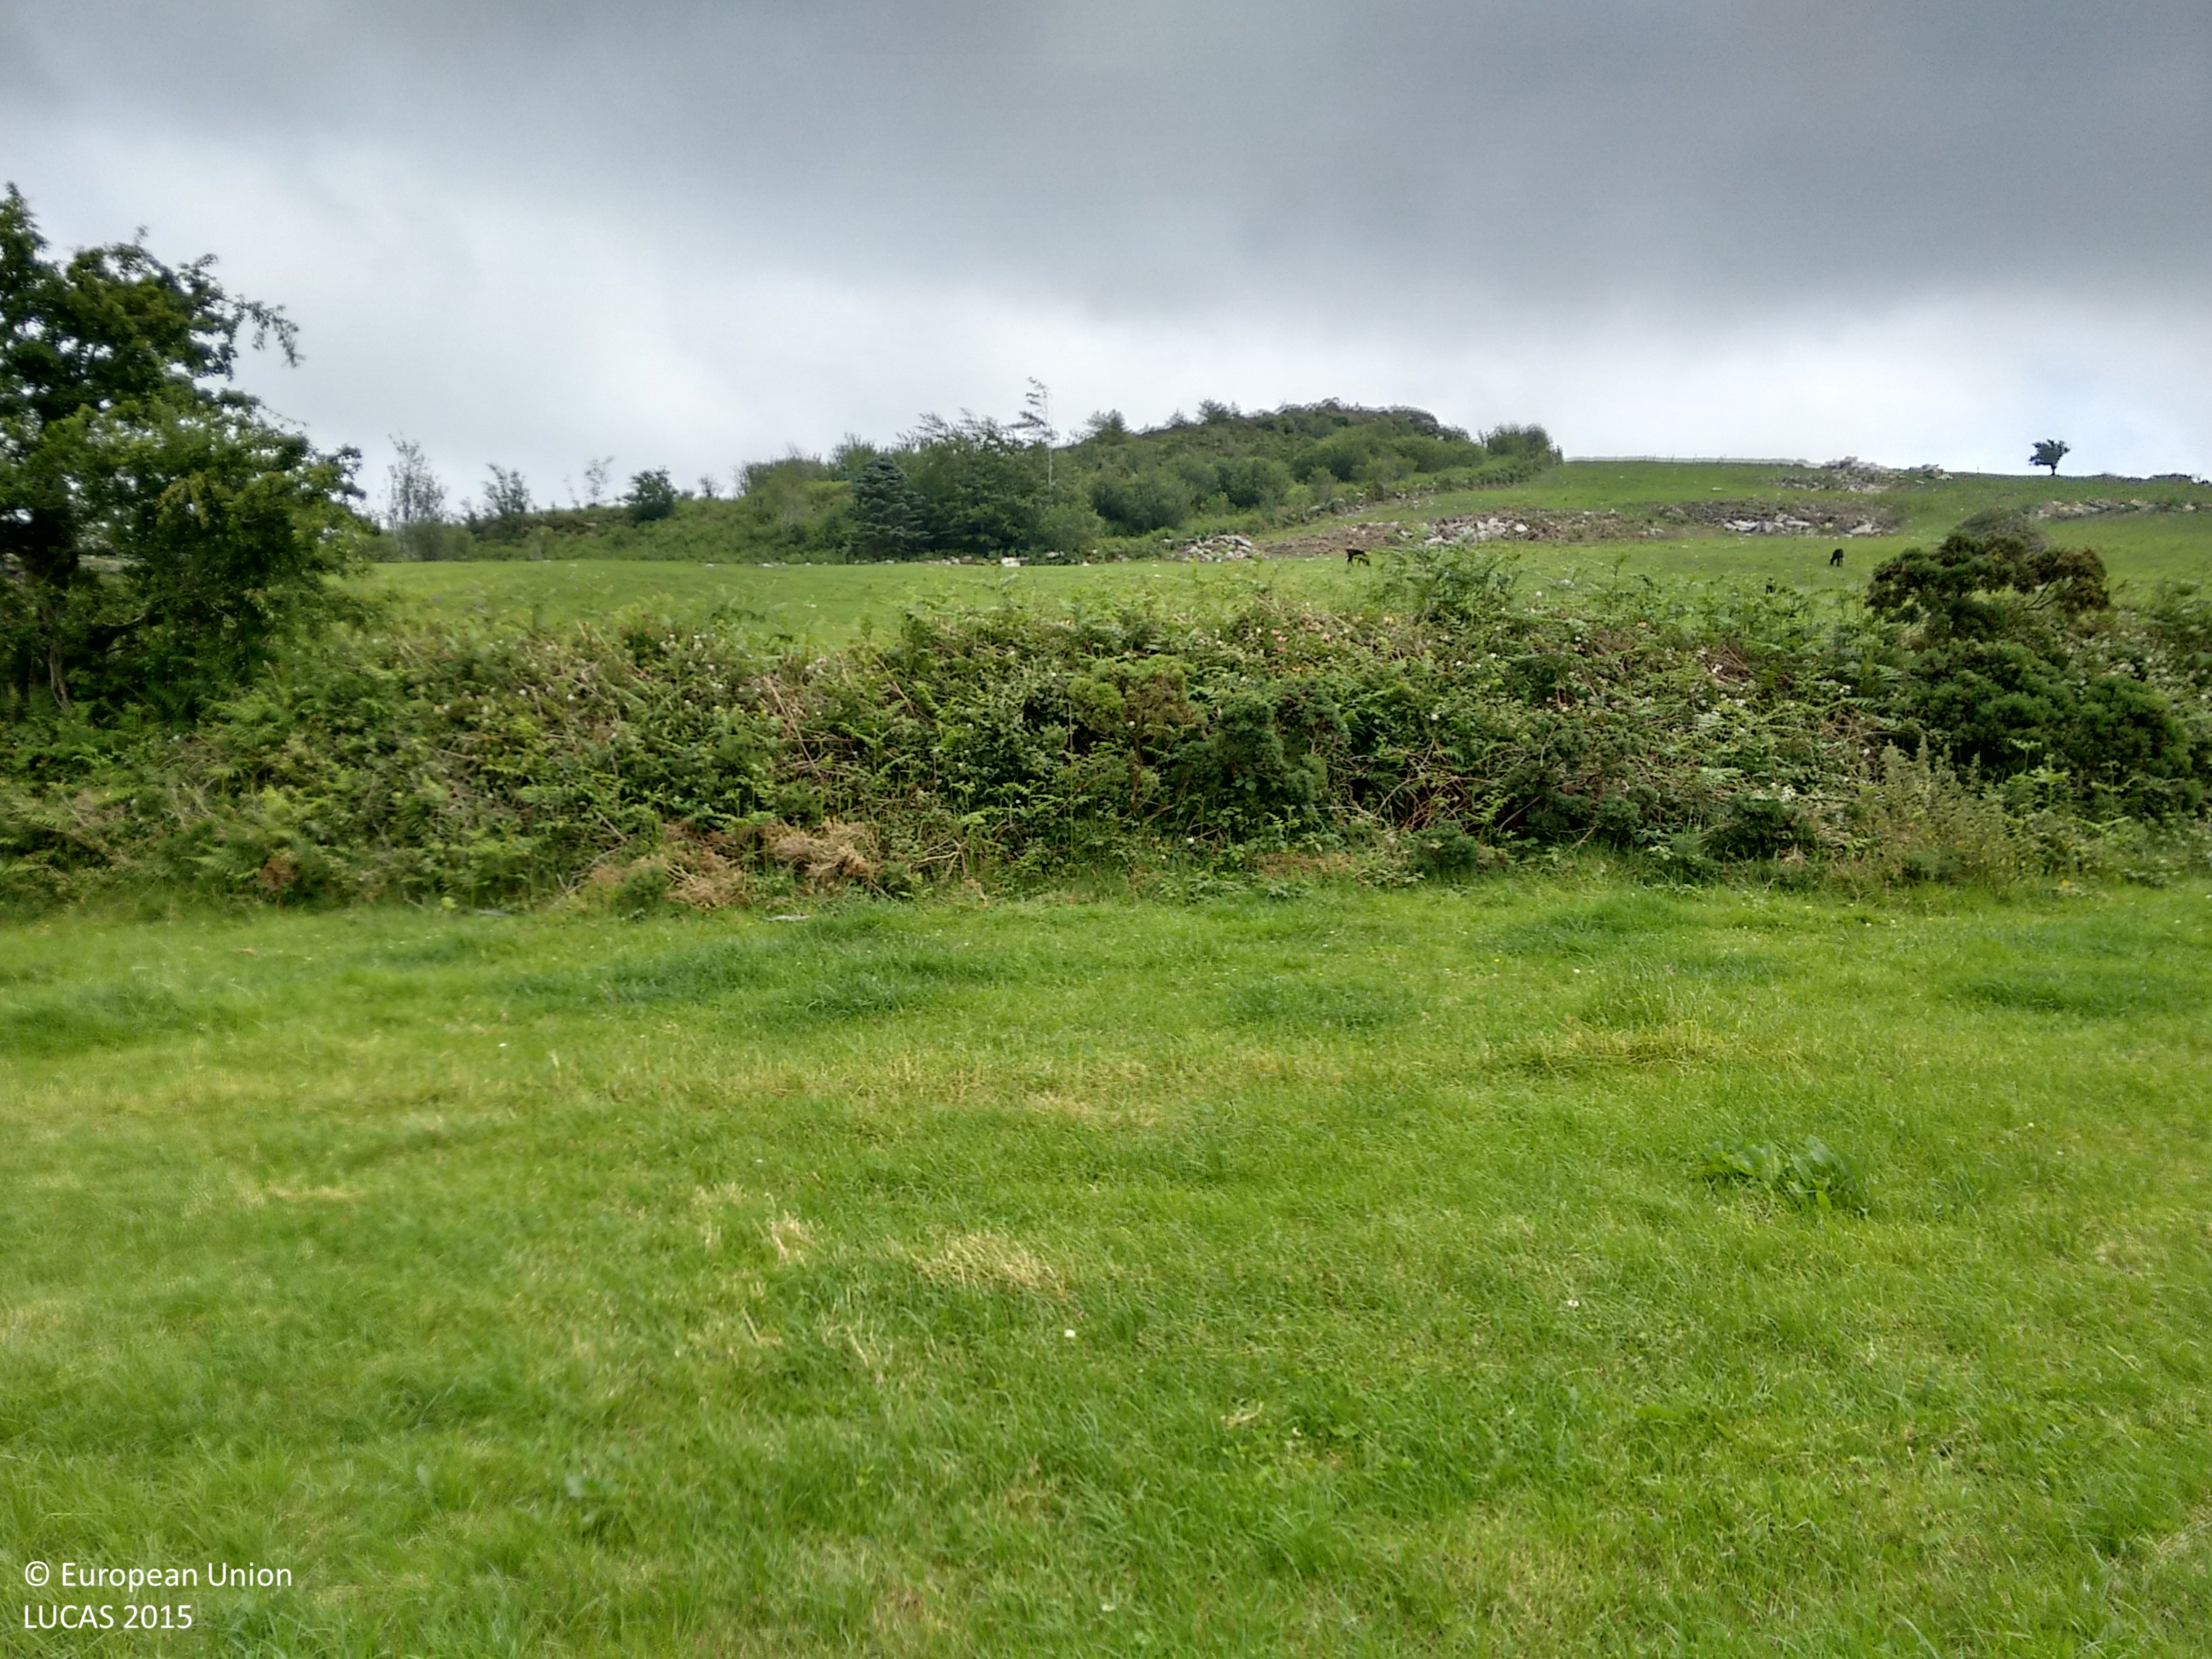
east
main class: Grassland
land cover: Grassland without tree/shrub cover
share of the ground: > 75 %
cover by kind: herbaceous plants 100 %
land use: Agriculture (excluding fallow land and kitchen gardens)
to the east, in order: Grassland without tree/shrub cover; Abandoned hedges; Paved roads, cycling and walking lanes; Abandoned hedges; Fences; Grassland without tree/shrub cover; Broadleaved woodland; Grassland without tree/shrub cover; Other coniferous woodland
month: June
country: IE
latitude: 52.4518
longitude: -7.3253
